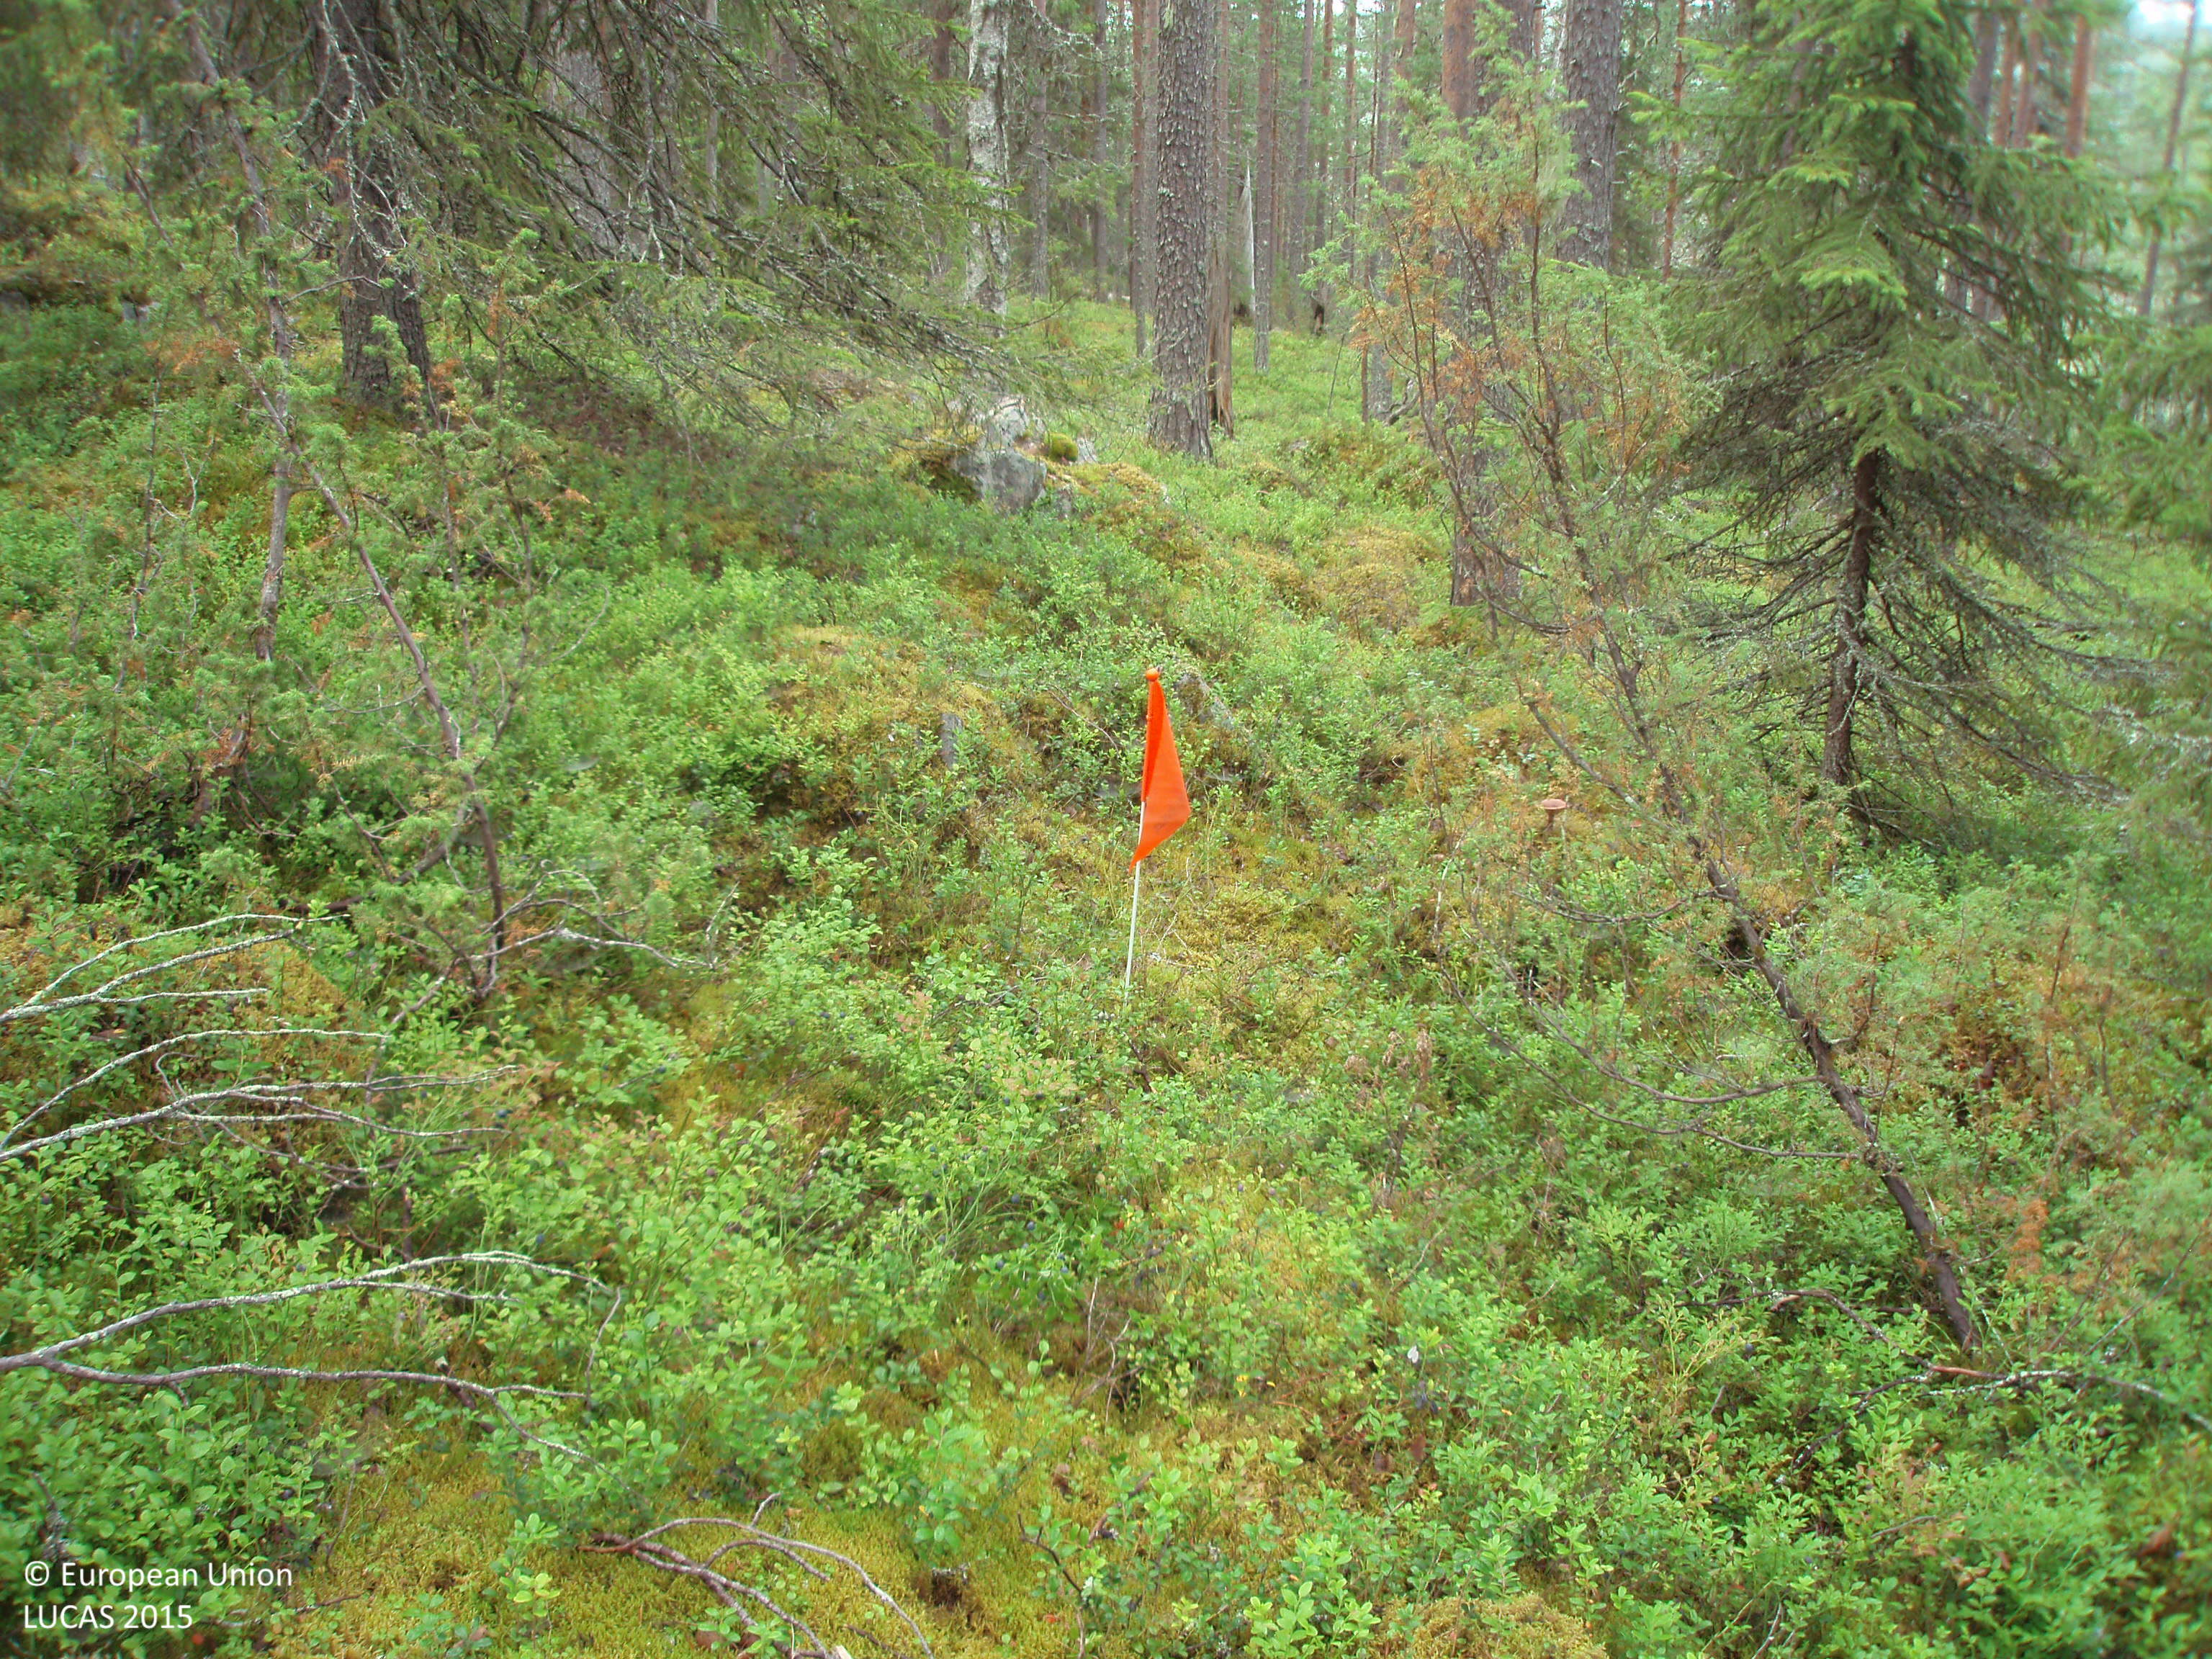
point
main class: Woodland
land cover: Other coniferous woodland
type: boreal forest
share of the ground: 50 - 75 %
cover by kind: coniferous forest trees 55 %, shrubs 30 %, broadleaved forest trees 15 %
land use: Semi-natural and natural areas not in use
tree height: > 5 m
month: August
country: FI
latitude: 65.5491
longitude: 27.3817
